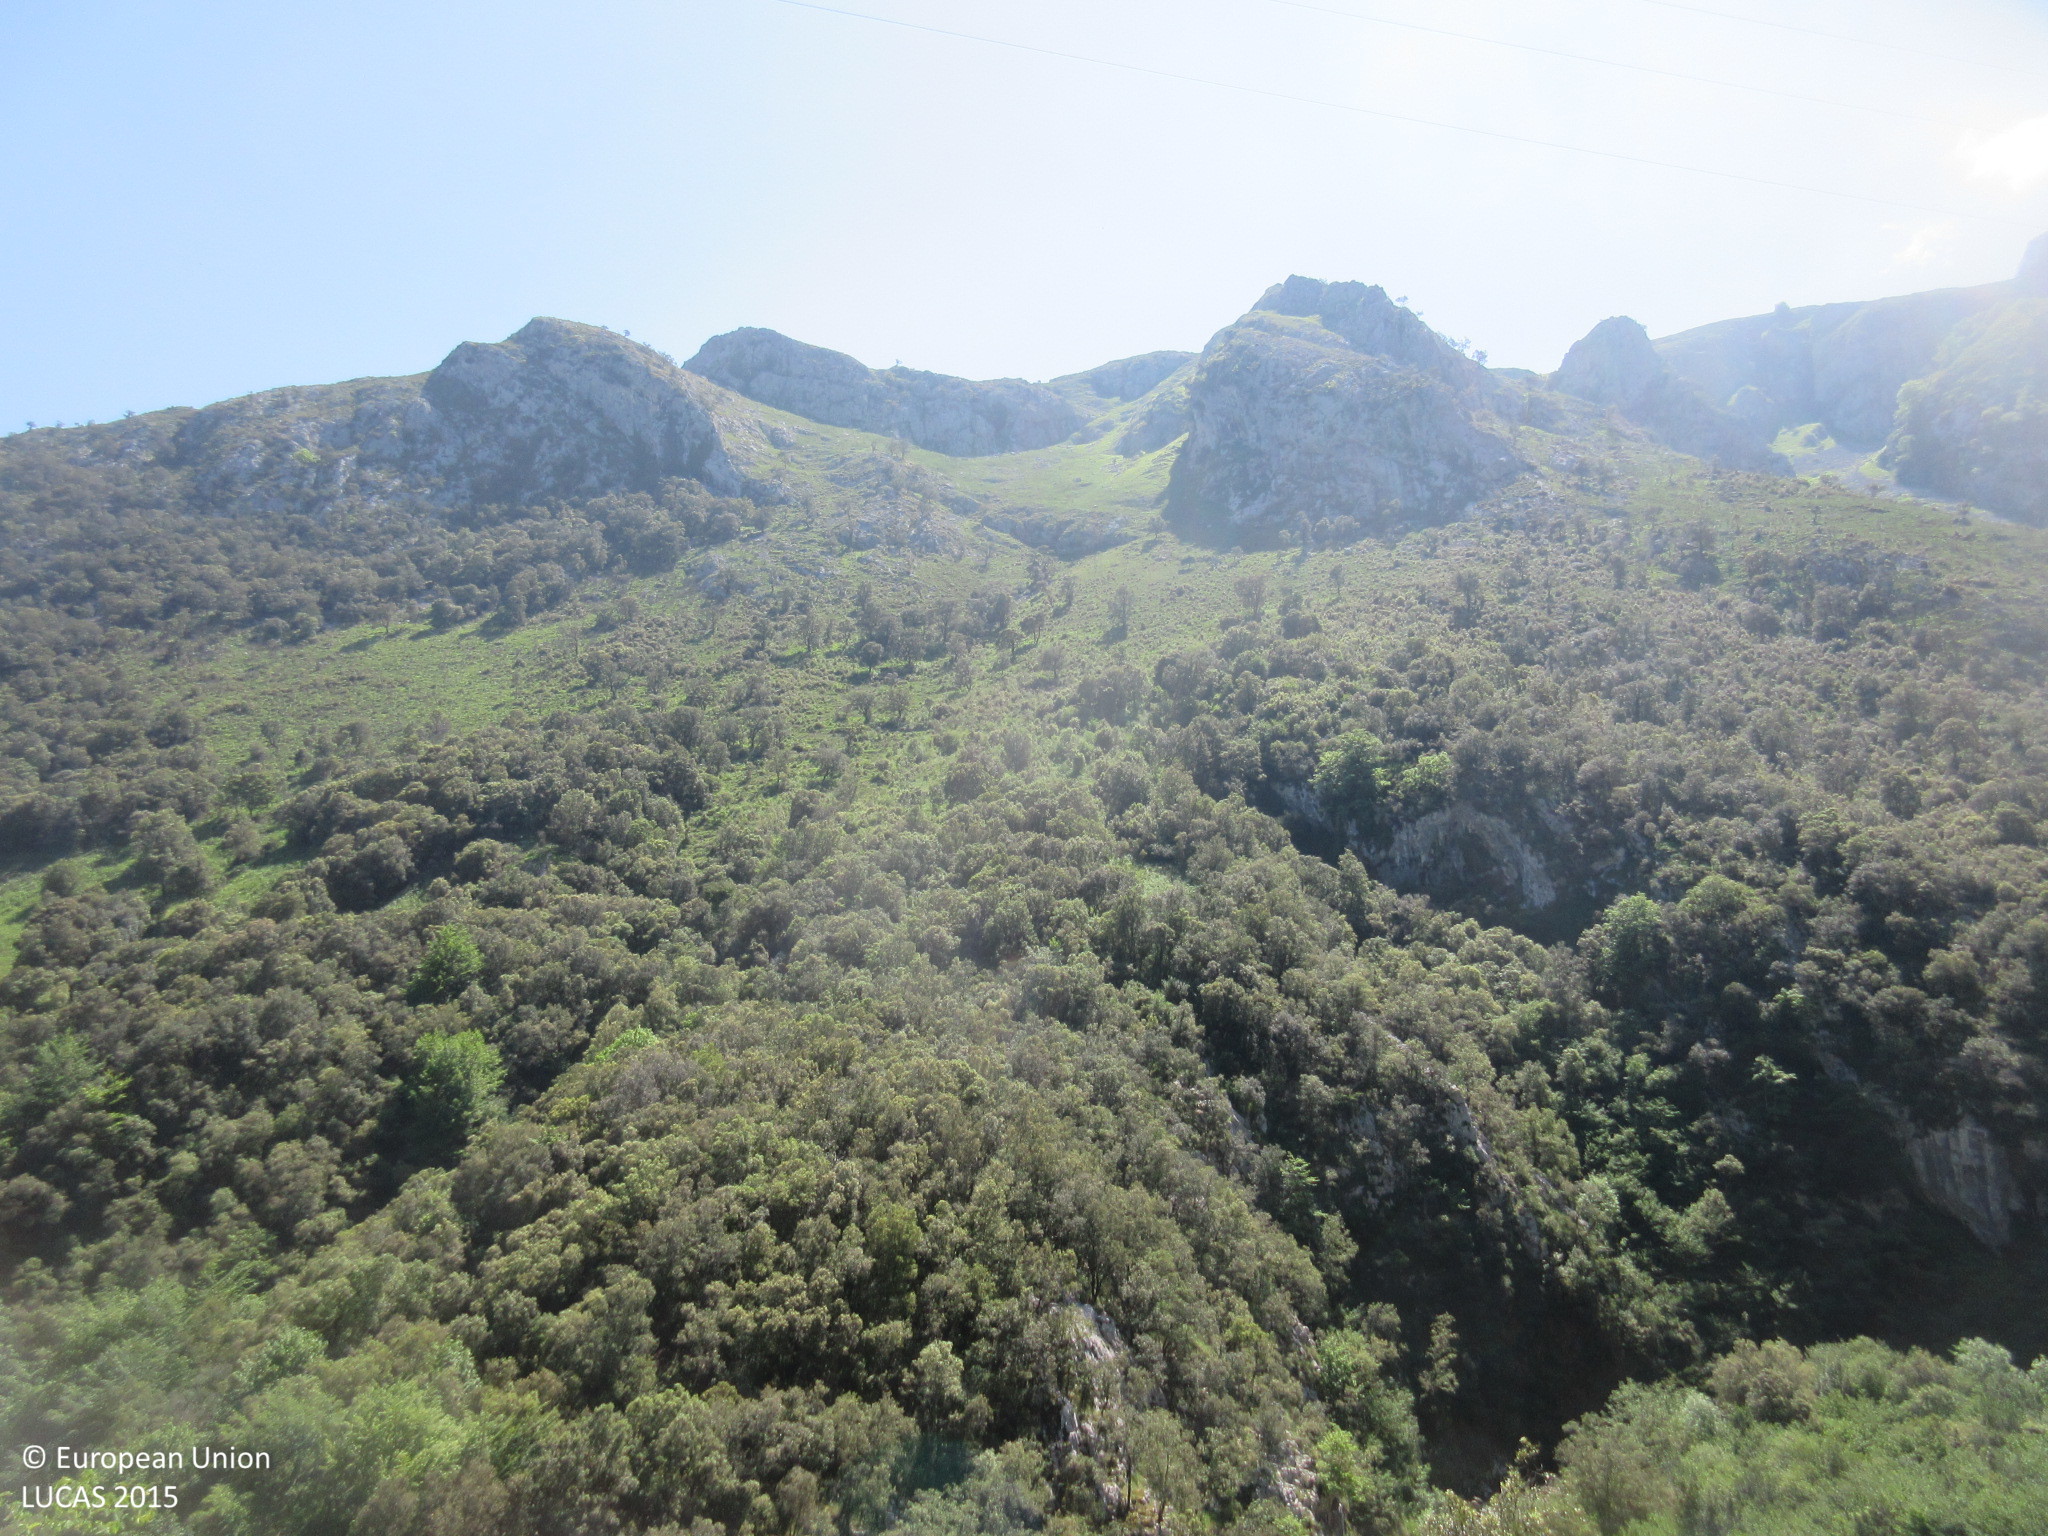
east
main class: Woodland
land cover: Broadleaved woodland
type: broadleaved evergreen forest
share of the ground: > 75 %
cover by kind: broadleaved forest trees 90 %, shrubs 5 %, herbaceous plants 5 %
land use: Semi-natural and natural areas not in use
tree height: > 5 m
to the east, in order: Broadleaved woodland; Rocks and stones; Broadleaved woodland; Paved roads, cycling and walking lanes; Dry stone walls; Broadleaved woodland; Inland fresh running water; Broadleaved woodland
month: May
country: ES
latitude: 43.2726
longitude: -4.4874
